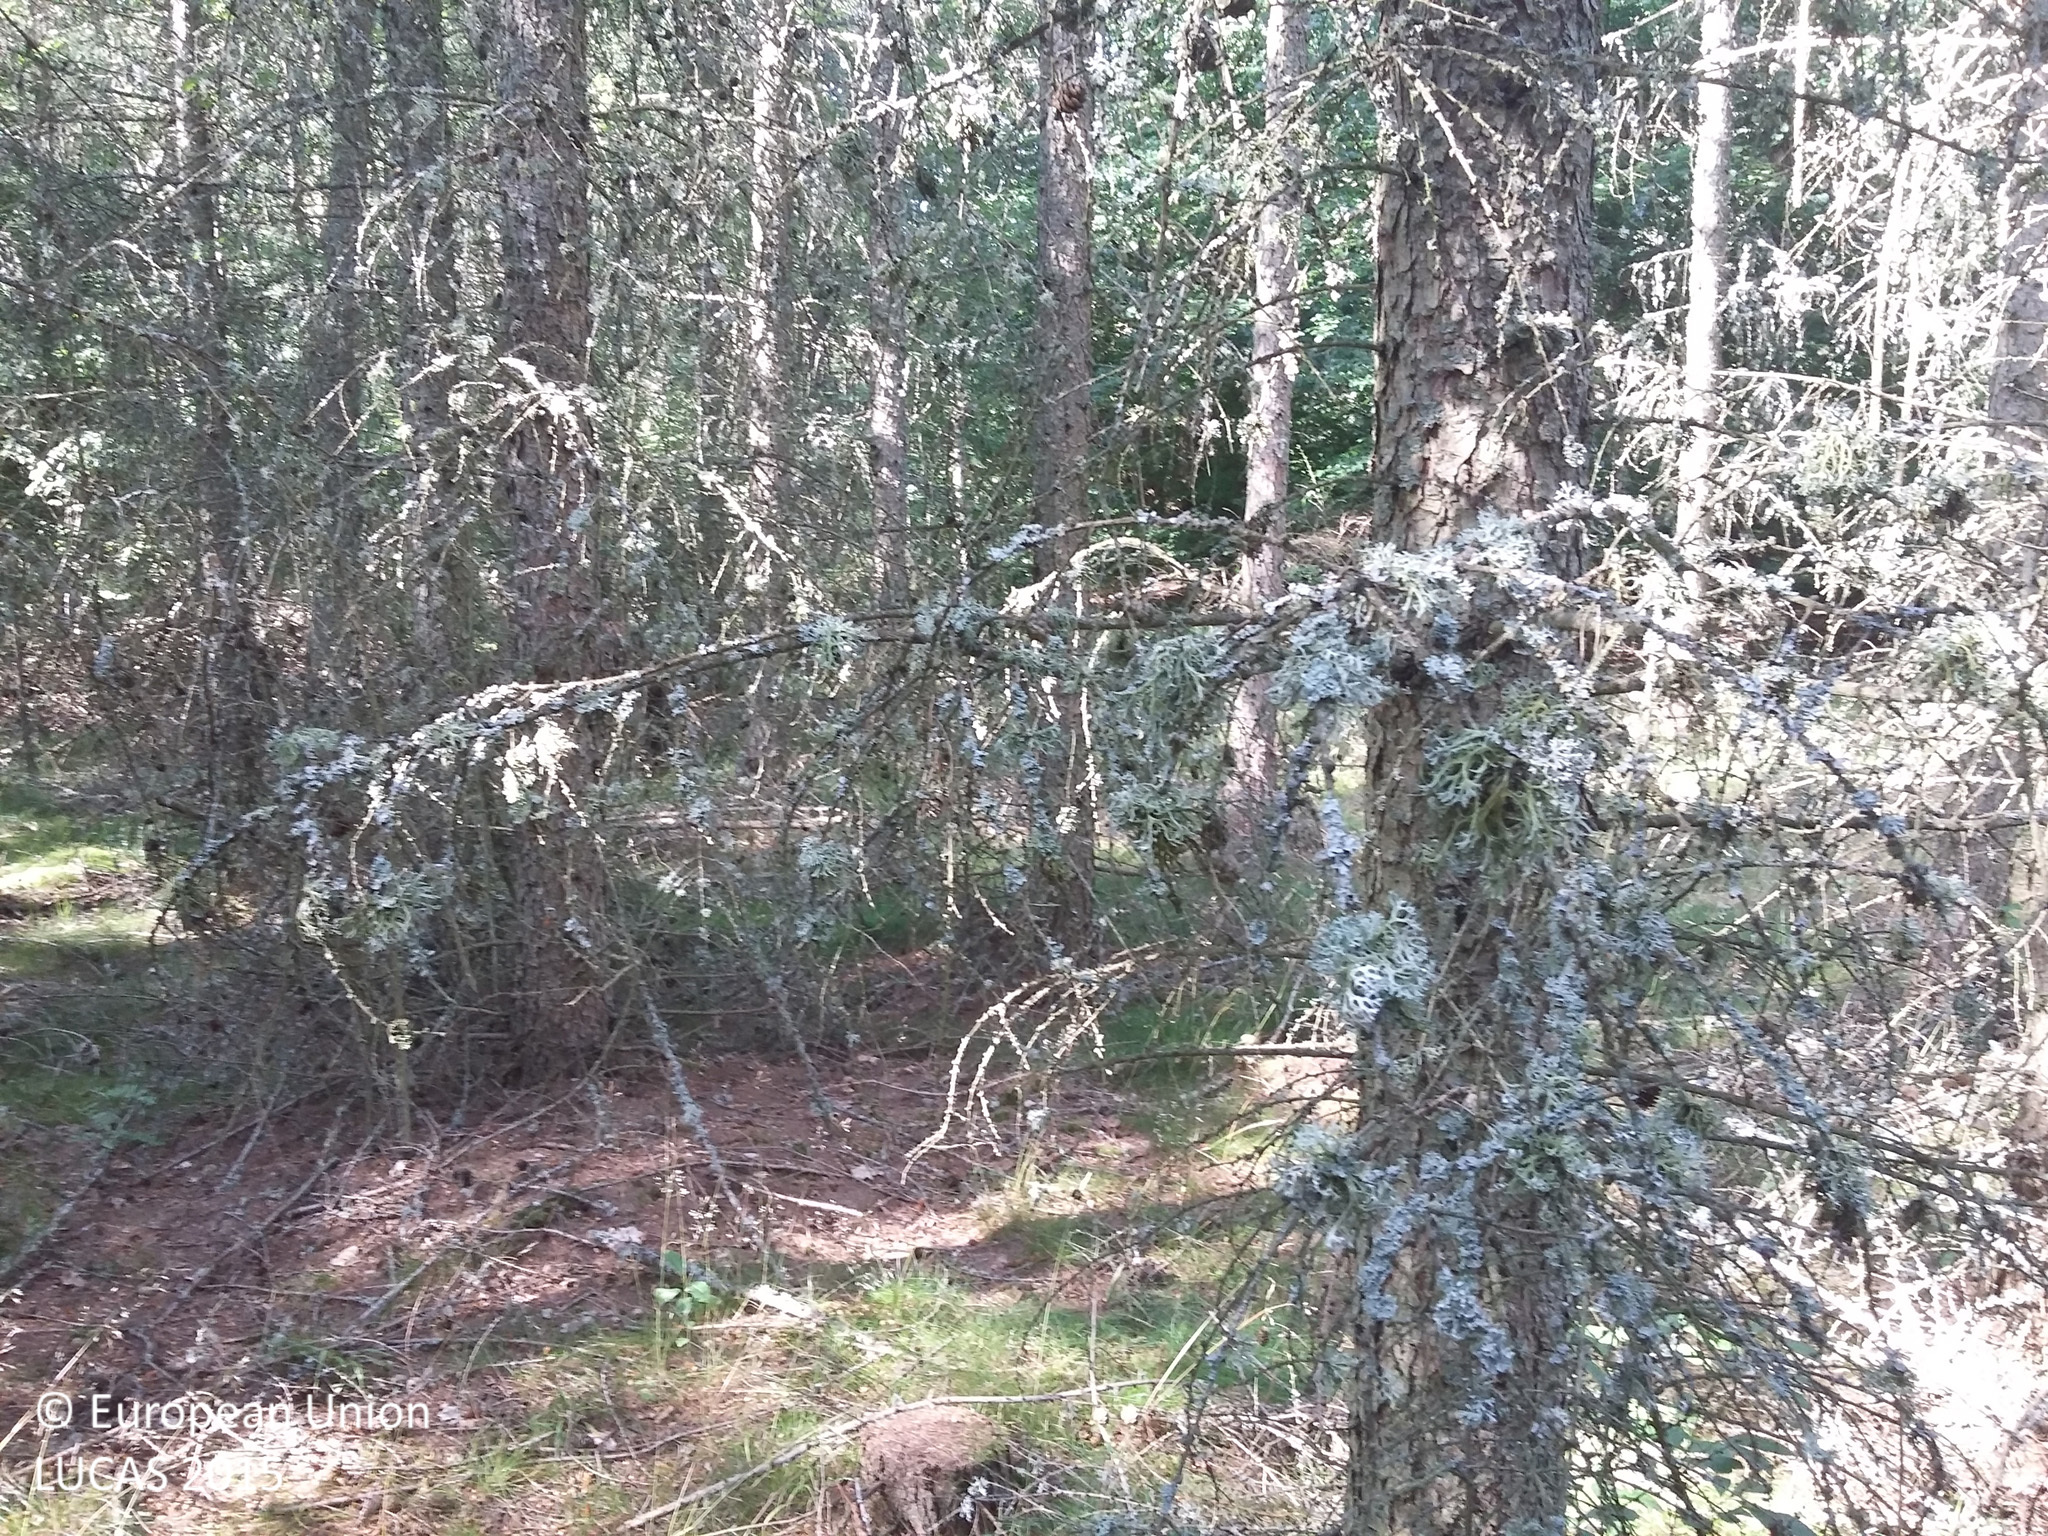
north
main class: Woodland
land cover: Pine dominated coniferous woodland
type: alpine coniferous forest
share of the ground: > 75 %
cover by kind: coniferous forest trees 80 %, herbaceous plants 10 %, lichens and mosses 10 %
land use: Forestry
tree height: > 5 m
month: July
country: DK
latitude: 56.0447
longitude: 12.1009
